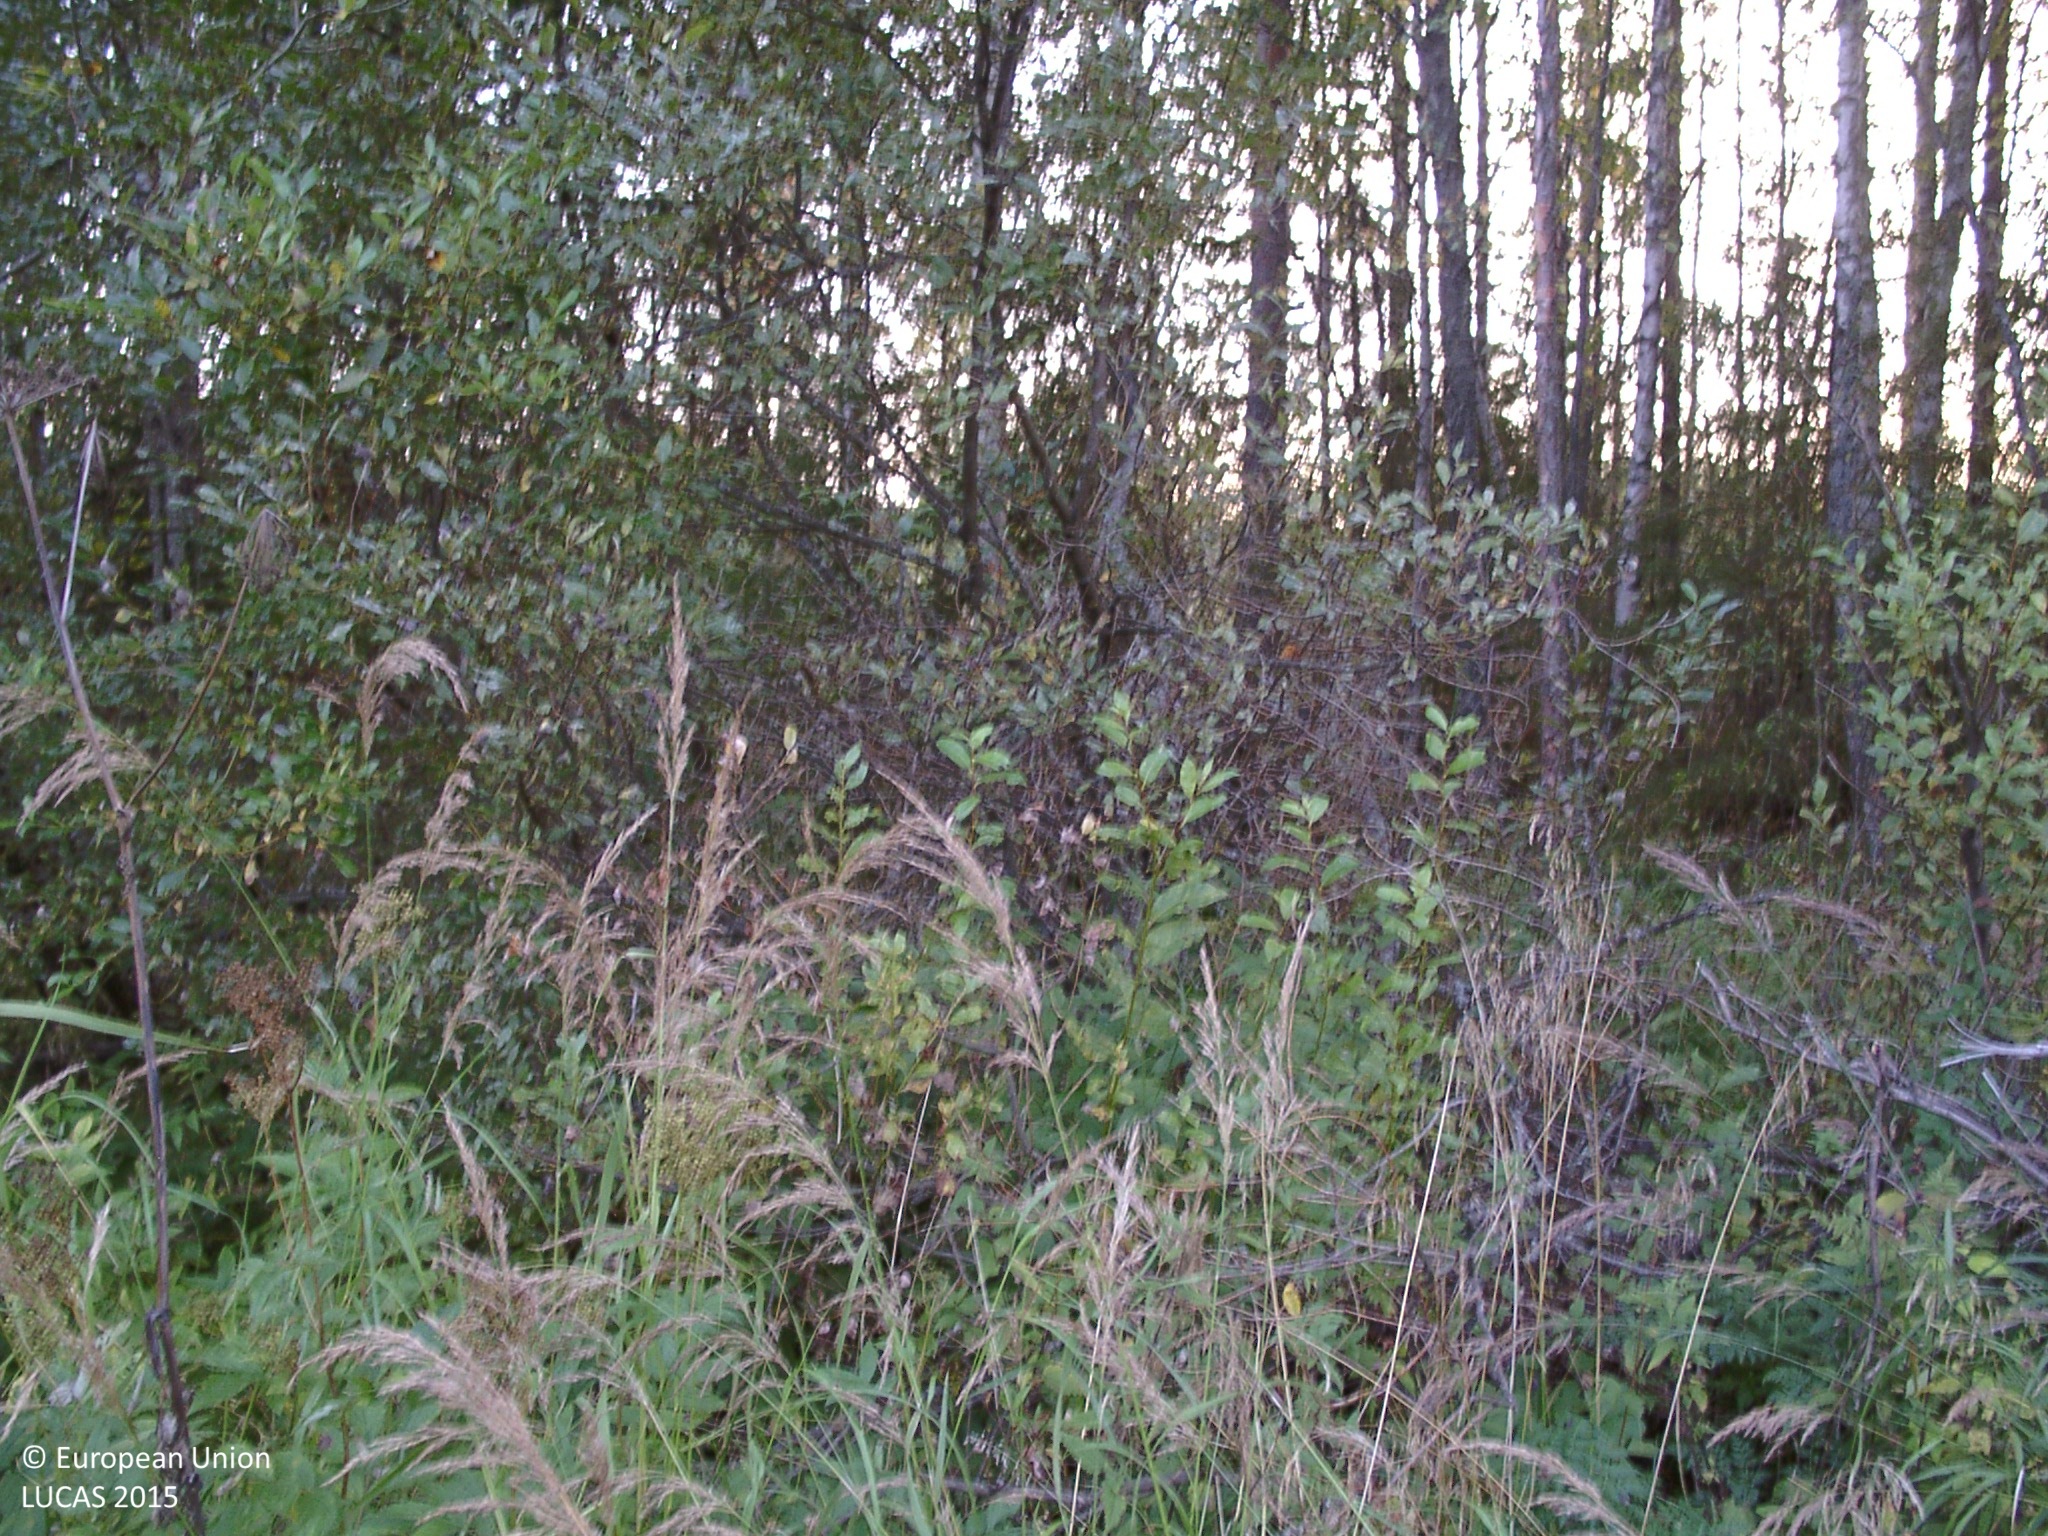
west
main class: Grassland
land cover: Grassland without tree/shrub cover
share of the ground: > 75 %
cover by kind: herbaceous plants 100 %
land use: Road transport
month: September
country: FI
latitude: 62.4087
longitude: 25.6970
